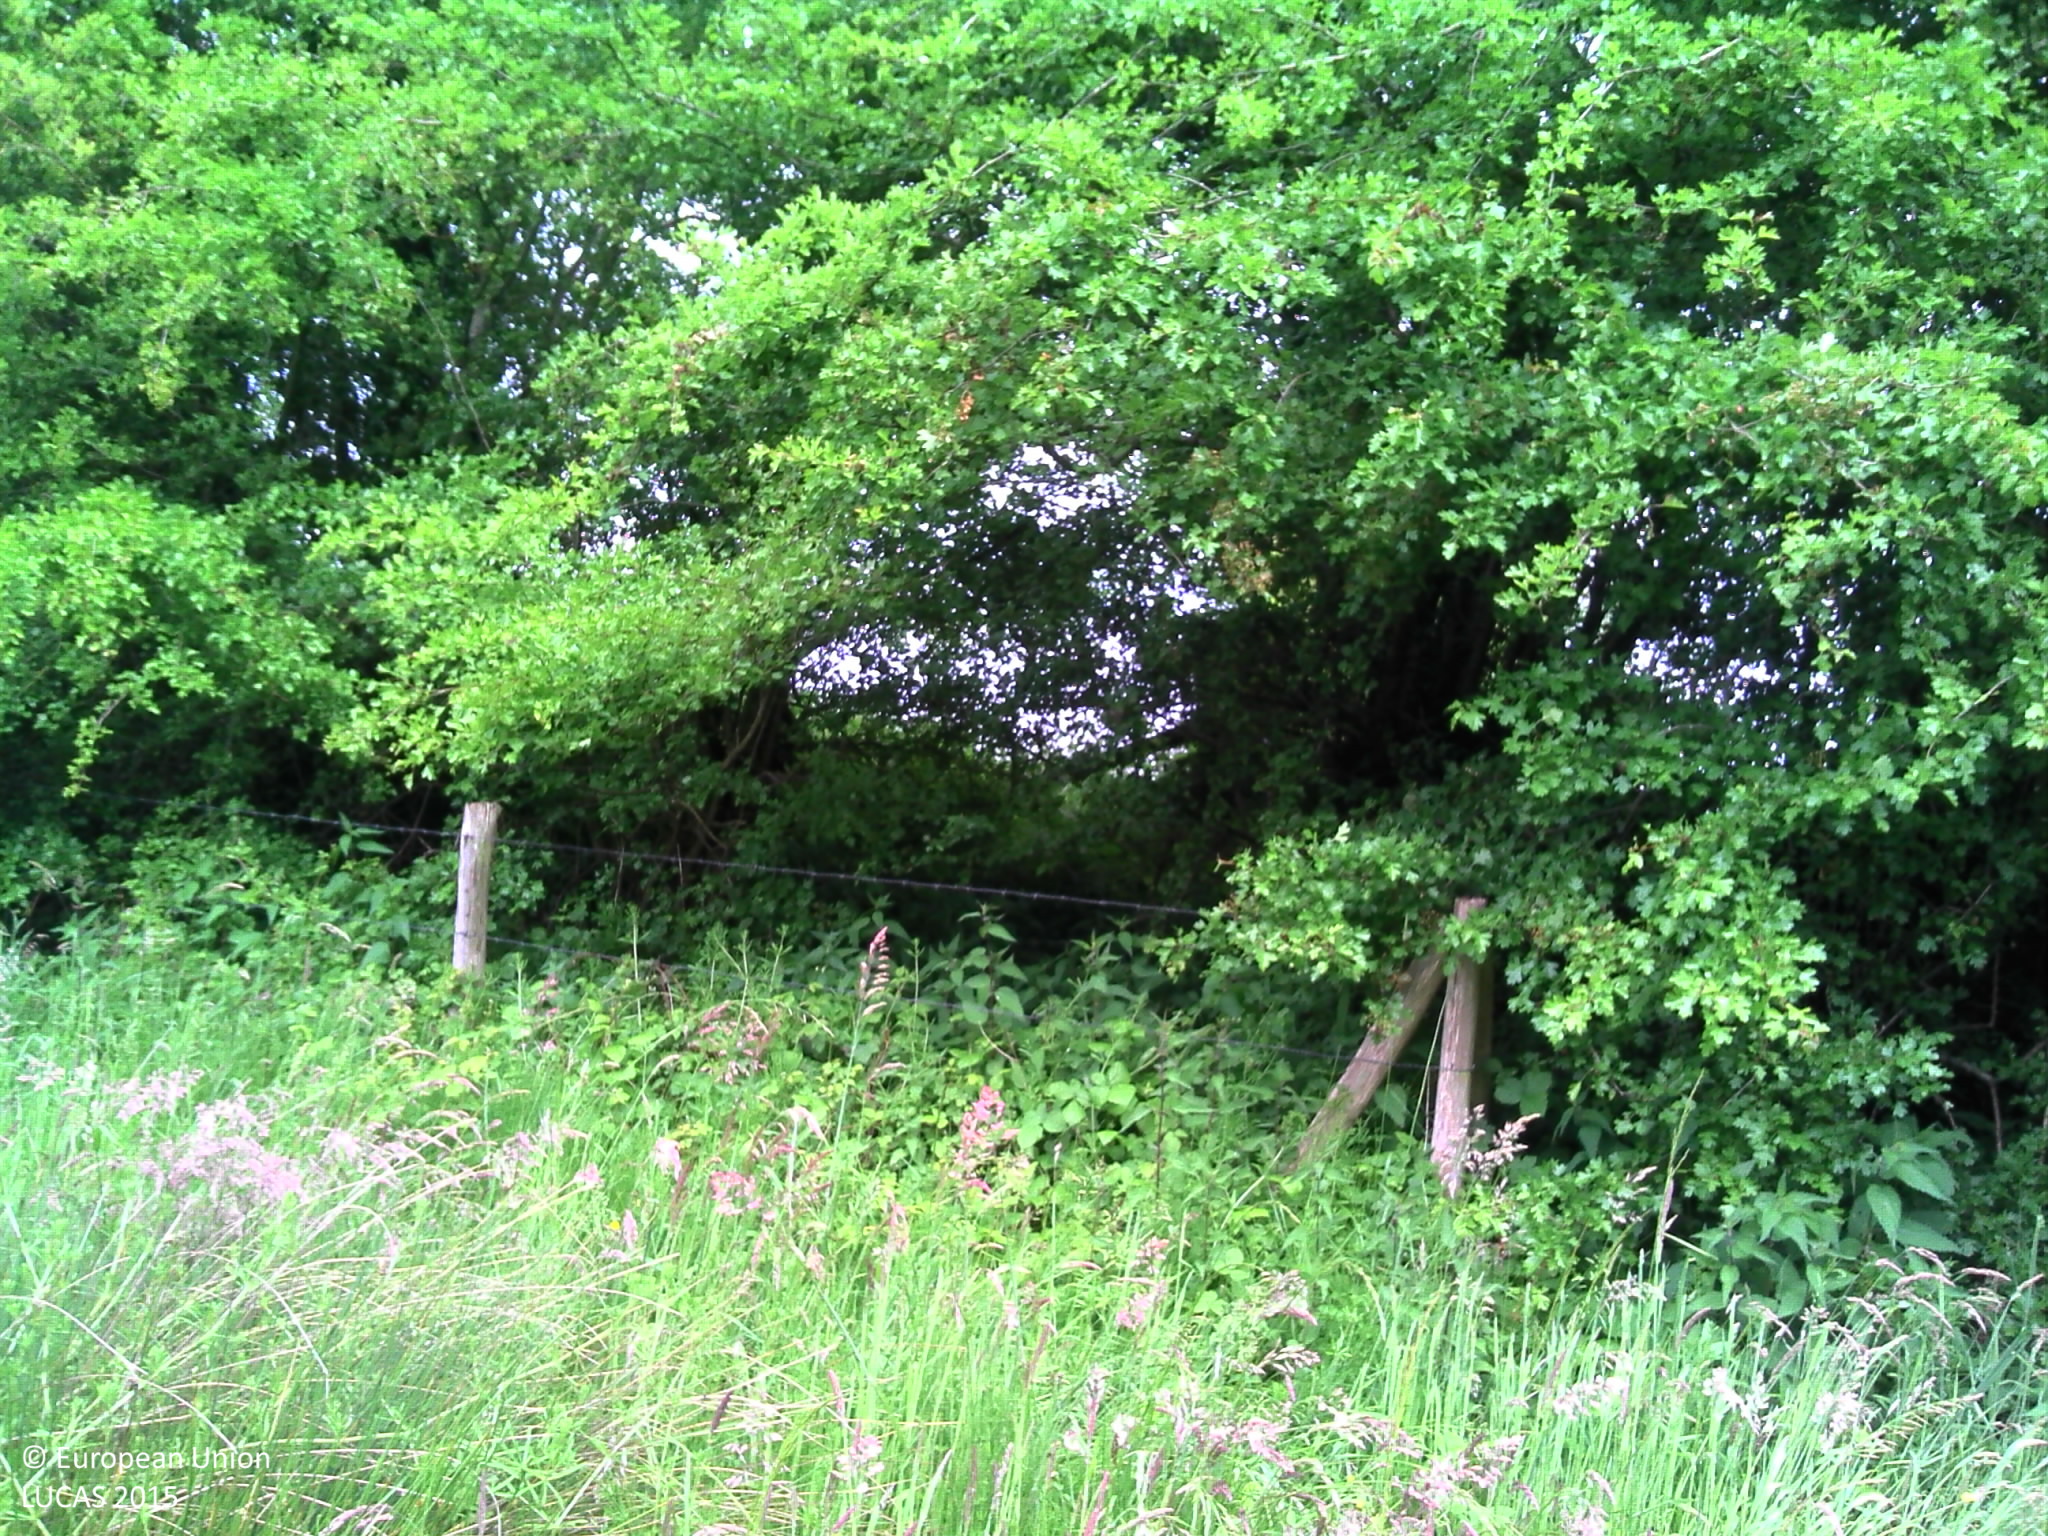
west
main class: Grassland
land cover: Grassland without tree/shrub cover
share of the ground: > 75 %
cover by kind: herbaceous plants 100 %
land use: Agriculture (excluding fallow land and kitchen gardens)
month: June
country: BE
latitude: 50.8041
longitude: 4.0488
